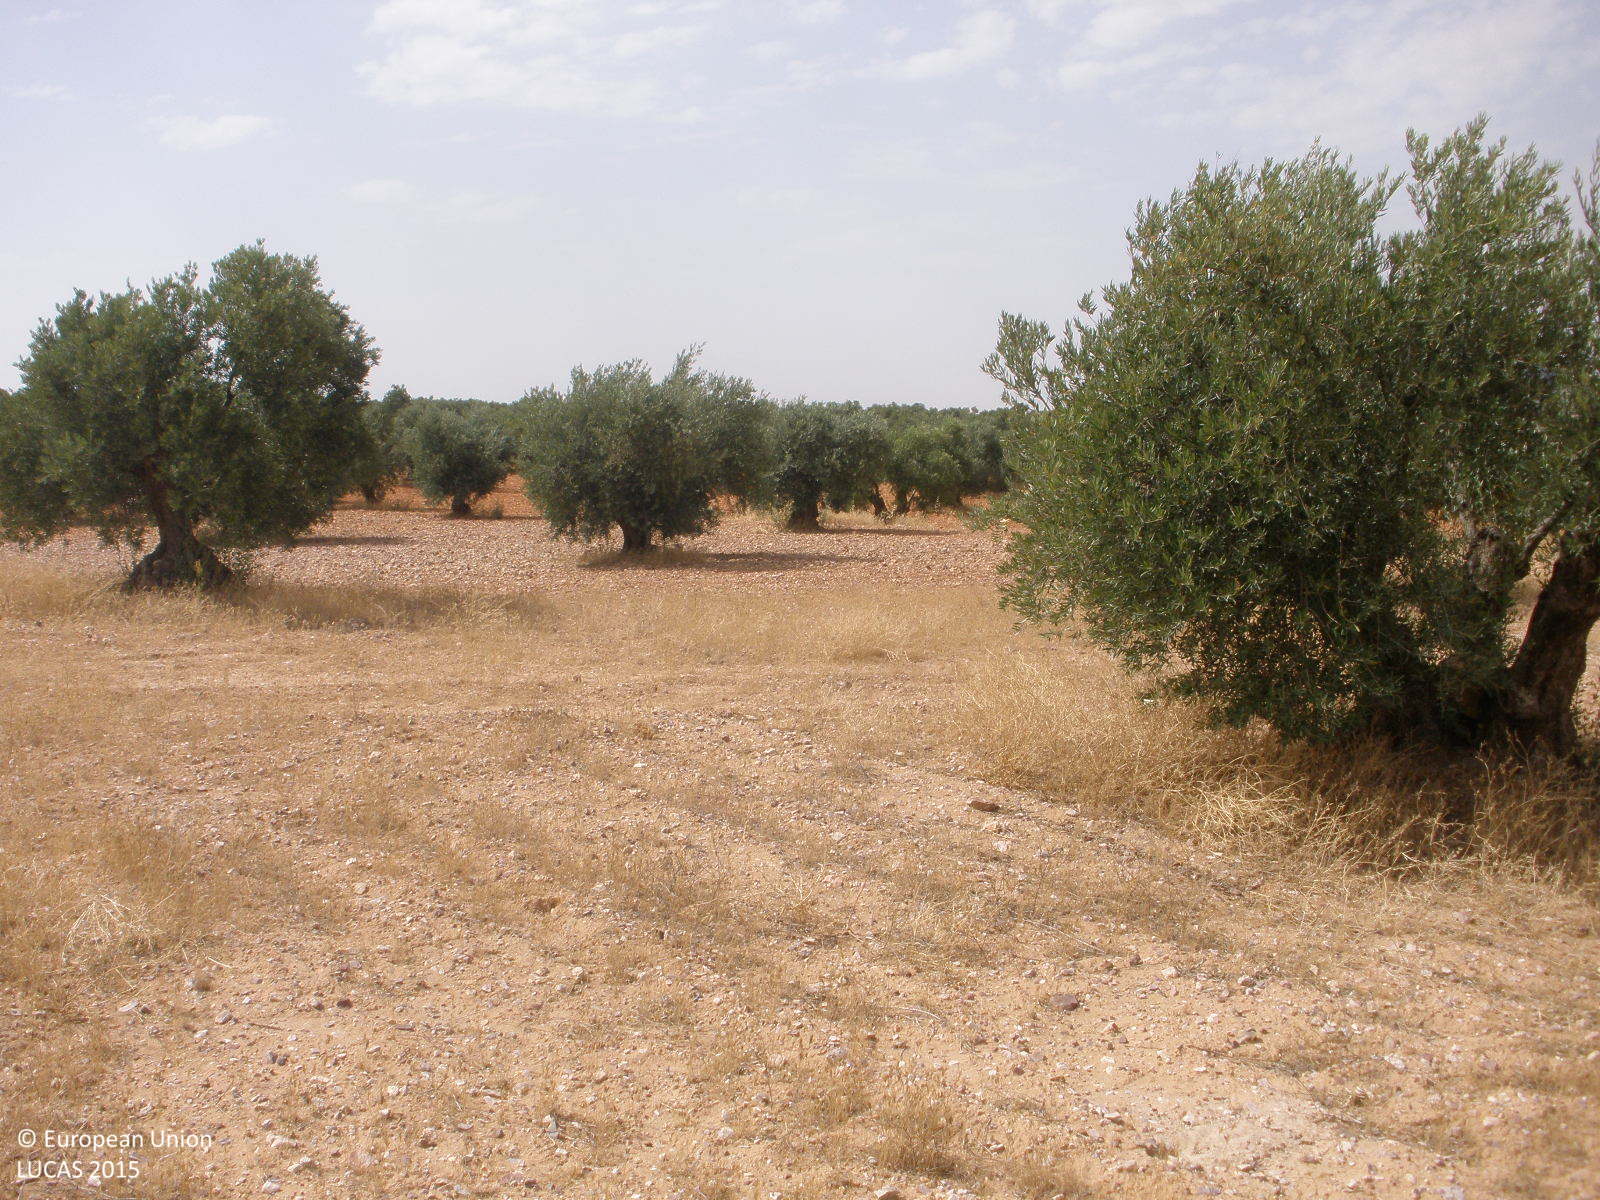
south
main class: Cropland
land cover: Olive groves
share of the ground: 25 - 50 %
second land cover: Spontaneously vegetated surfaces
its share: 50 - 75 %
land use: Agriculture (excluding fallow land and kitchen gardens)
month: July
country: ES
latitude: 39.6706
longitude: -3.4185
